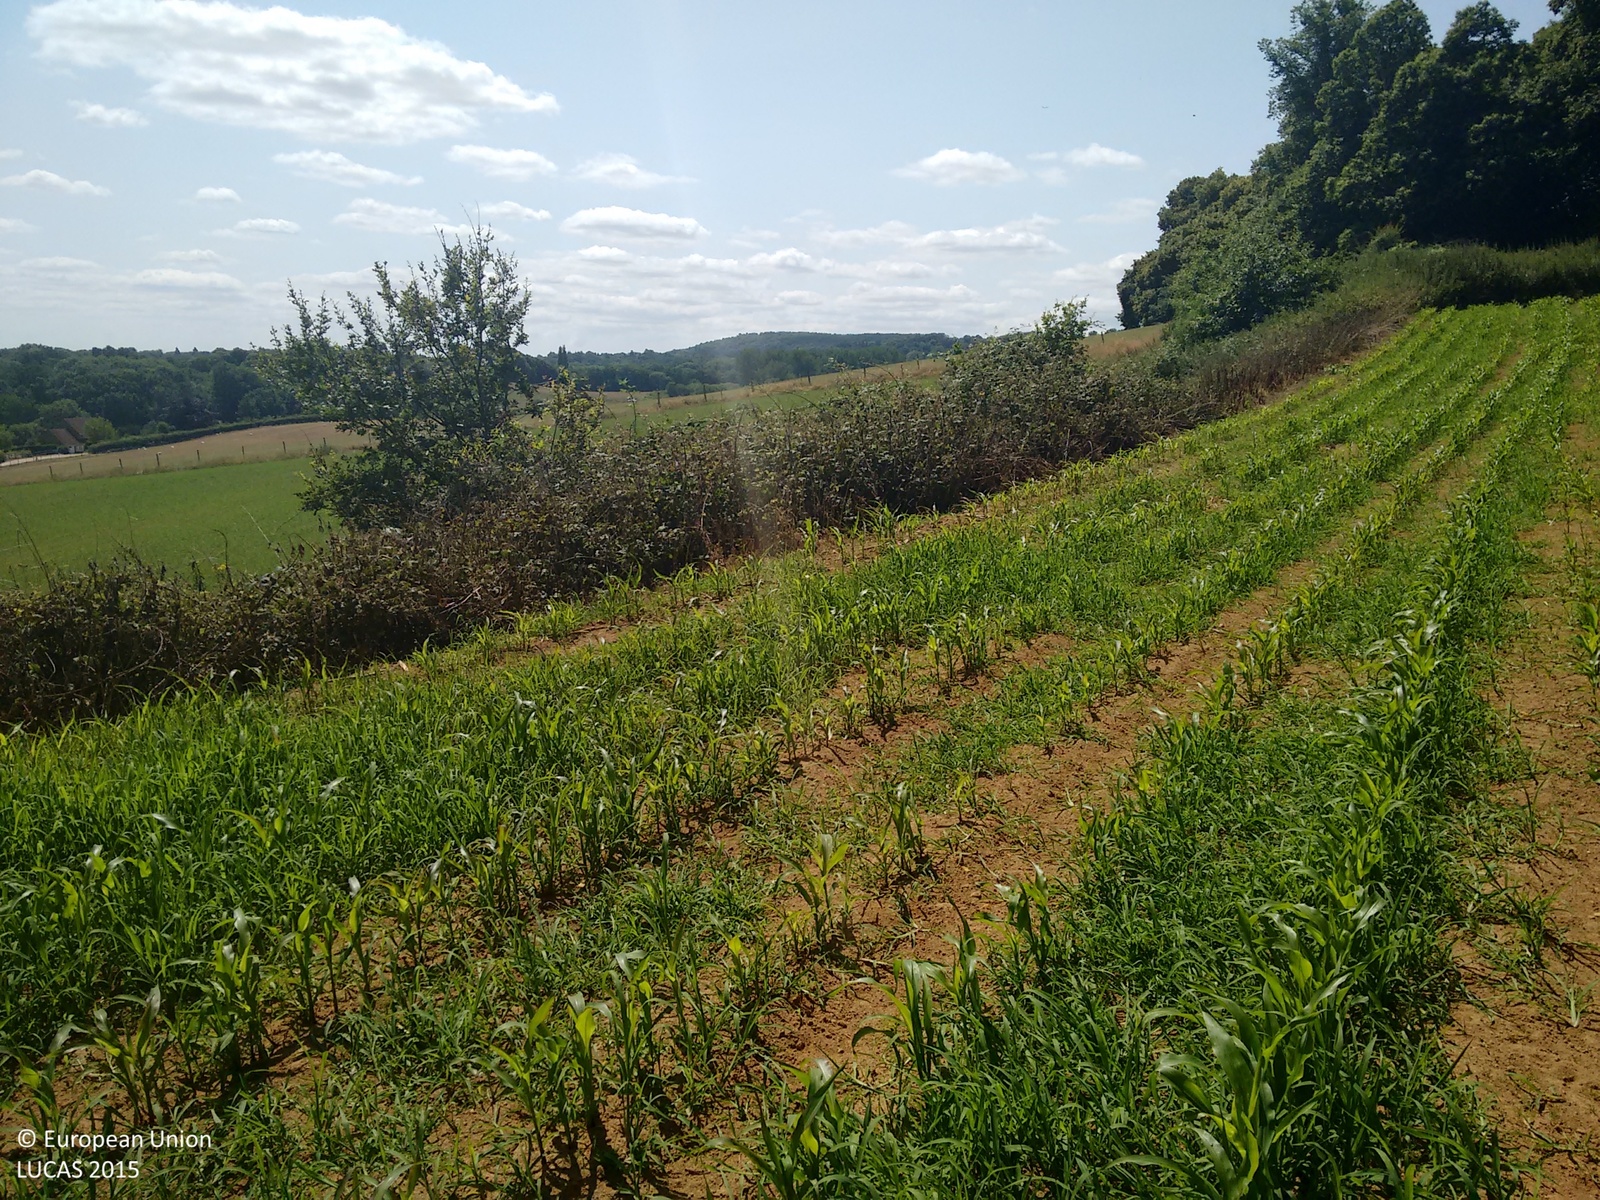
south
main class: Cropland
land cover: Maize
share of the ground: 10 - 25 %
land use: Agriculture (excluding fallow land and kitchen gardens)
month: July
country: GB
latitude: 51.1802
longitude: -0.5534
